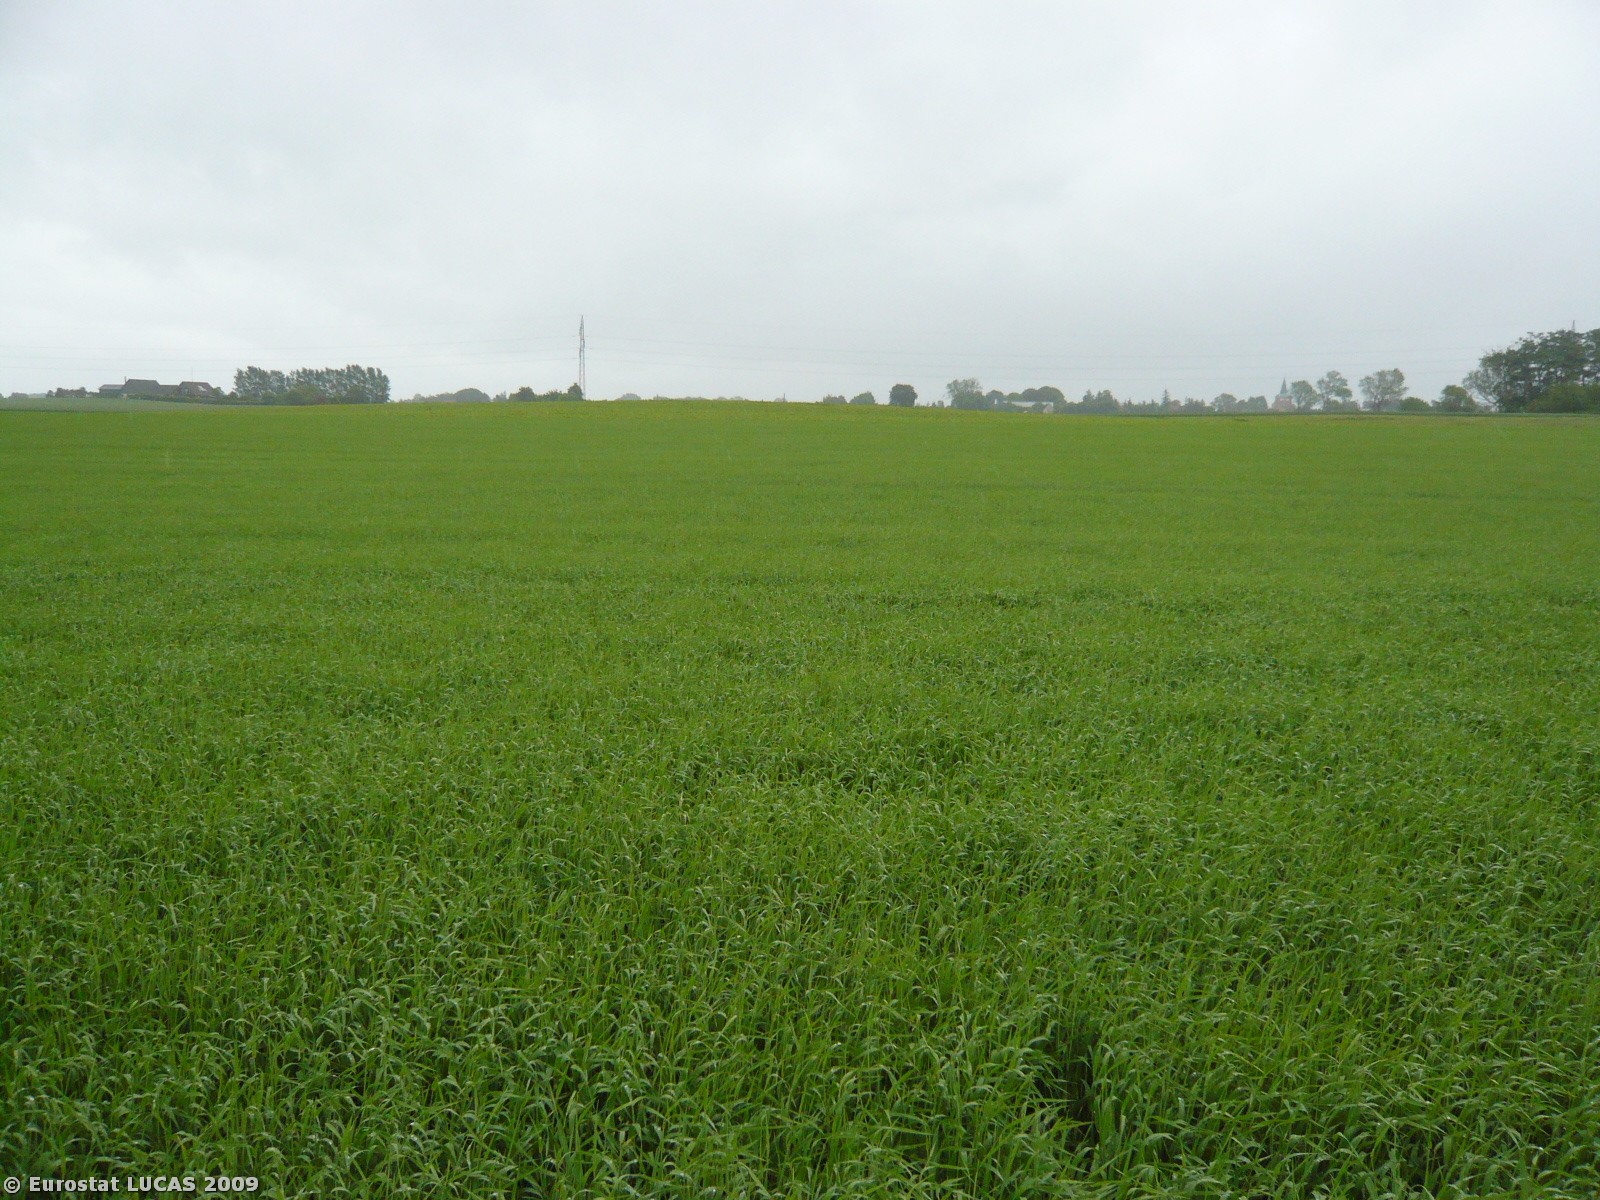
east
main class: Cropland
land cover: Barley
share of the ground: > 75 %
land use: Agriculture (excluding fallow land and kitchen gardens)
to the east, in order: Barley; Sugar beet; Common wheat
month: June
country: DK
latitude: 54.7891
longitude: 11.9116
